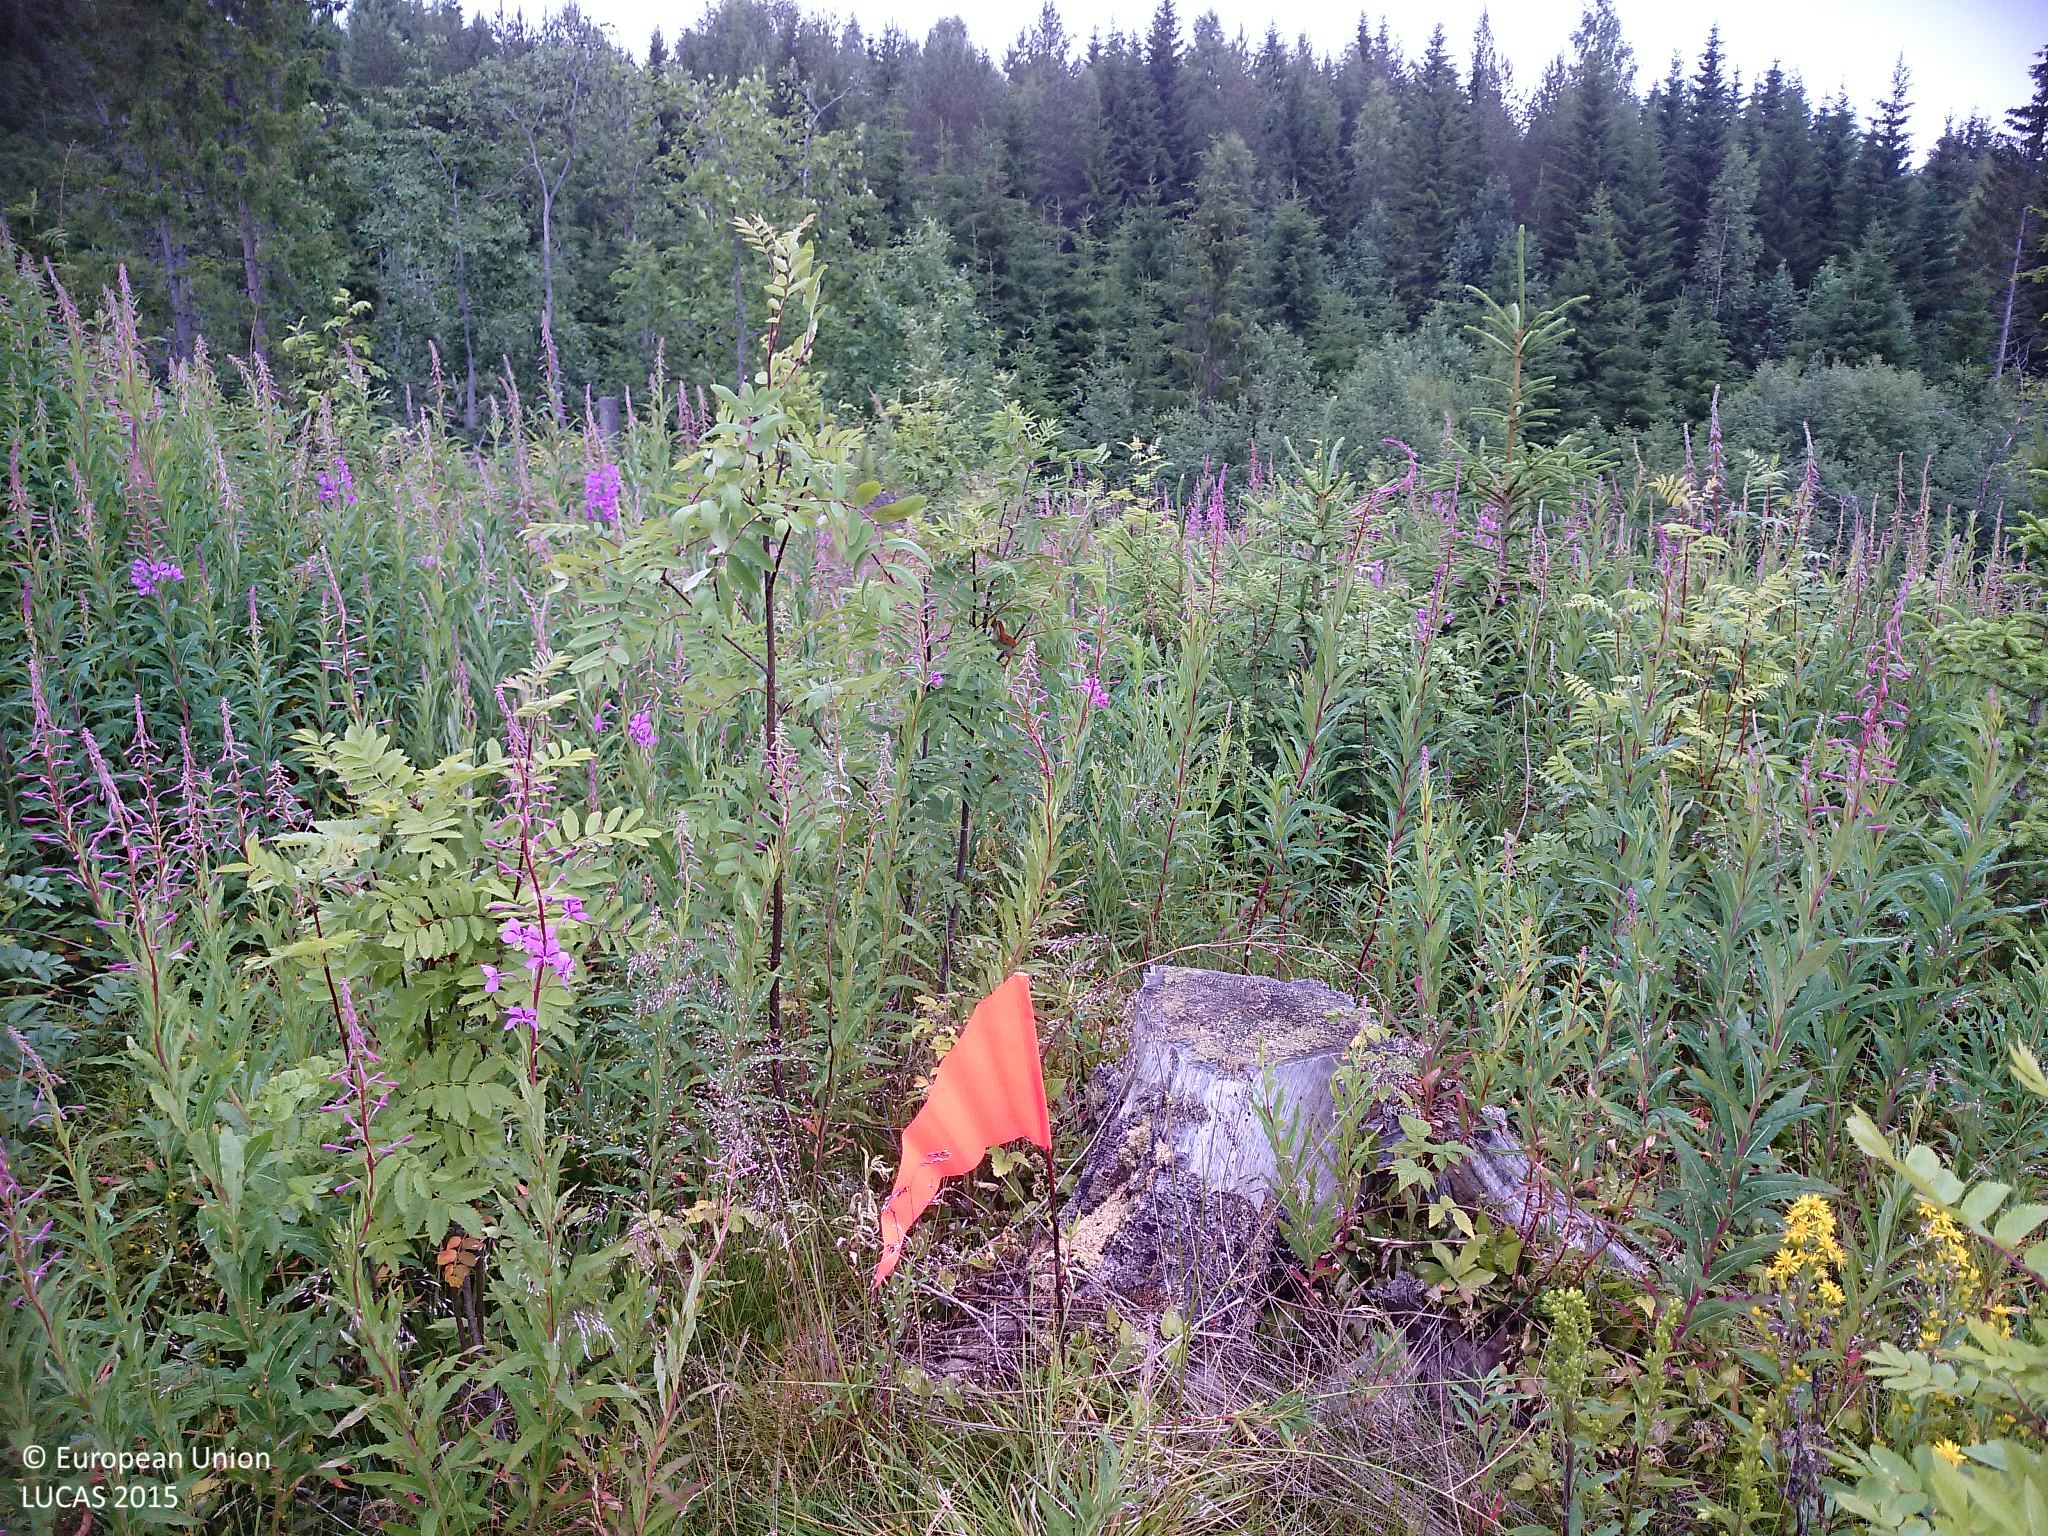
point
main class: Woodland
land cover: Pine dominated mixed woodland
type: boreal forest
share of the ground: 10 - 25 %
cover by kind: shrubs 40 %, herbaceous plants 40 %, coniferous forest trees 10 %, broadleaved forest trees 10 %
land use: Forestry
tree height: < 5 m
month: July
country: SE
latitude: 62.5522
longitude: 17.8565
